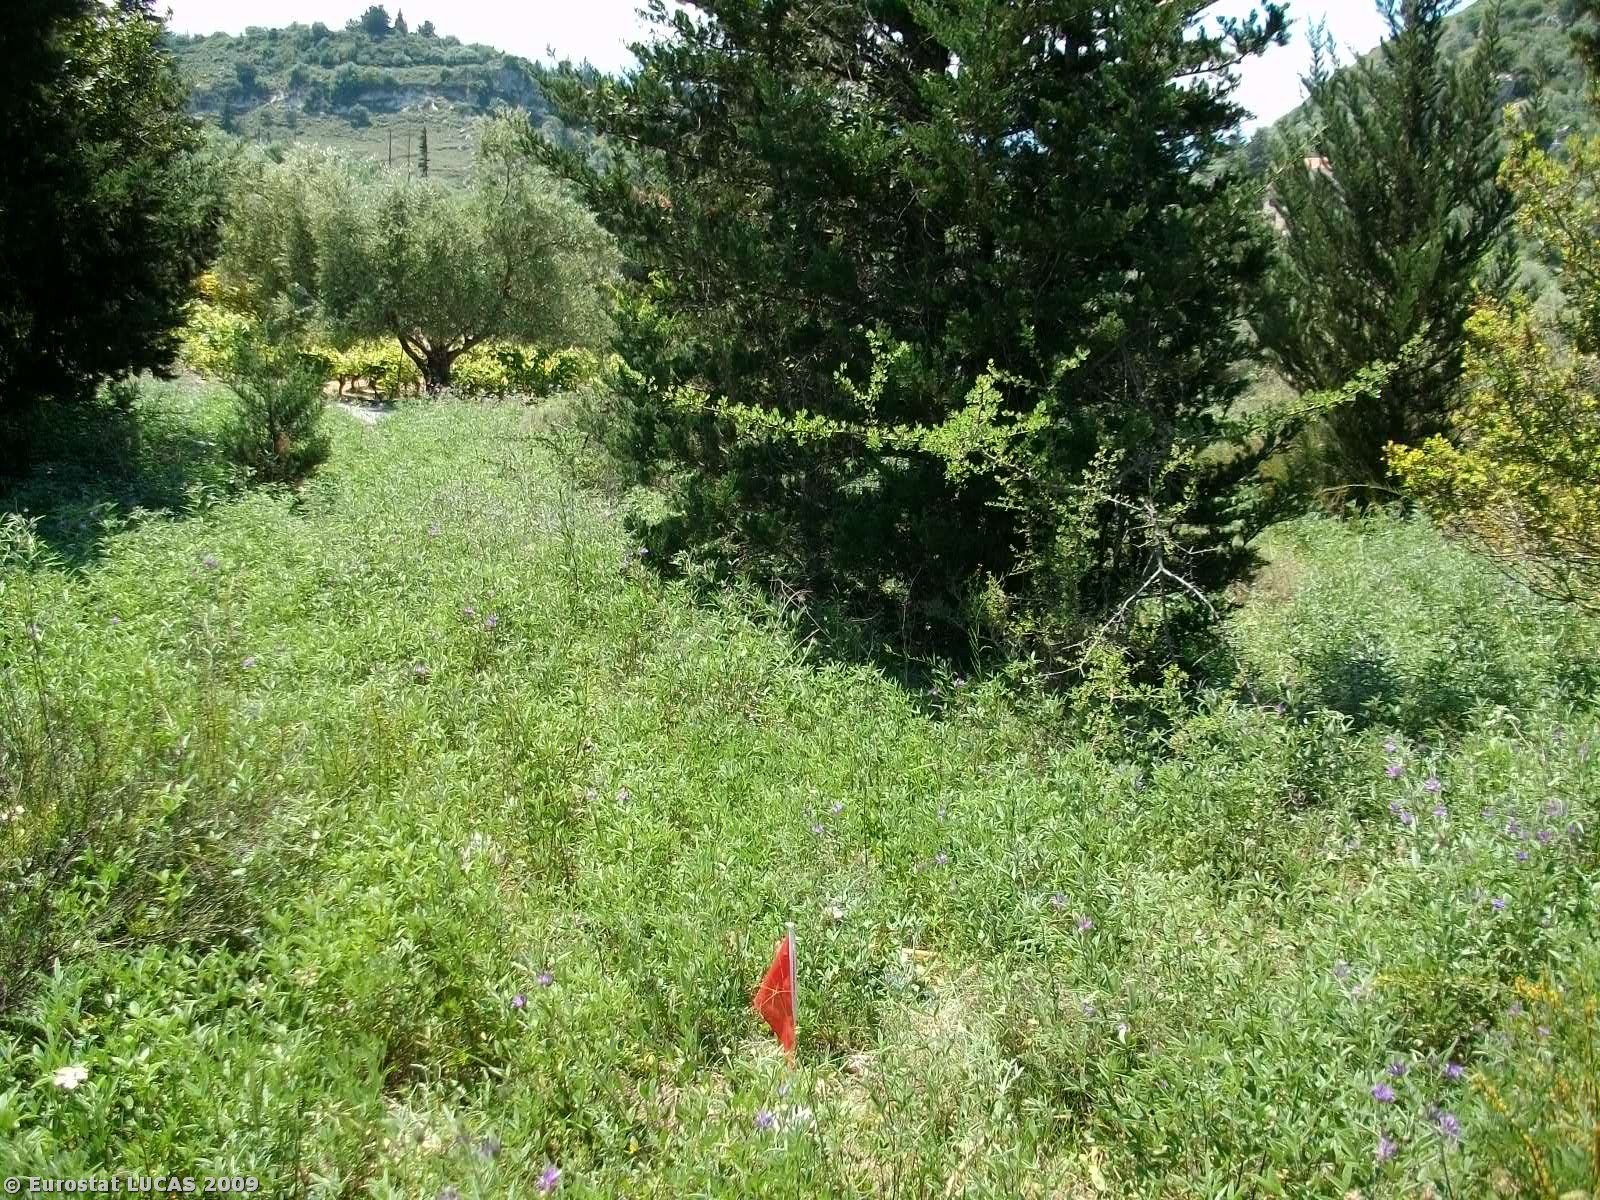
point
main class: Woodland
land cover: Mixed woodland
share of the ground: 25 - 50 %
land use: Forestry
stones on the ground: < 10 %
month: May
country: GR
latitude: 35.3673
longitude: 24.2159
